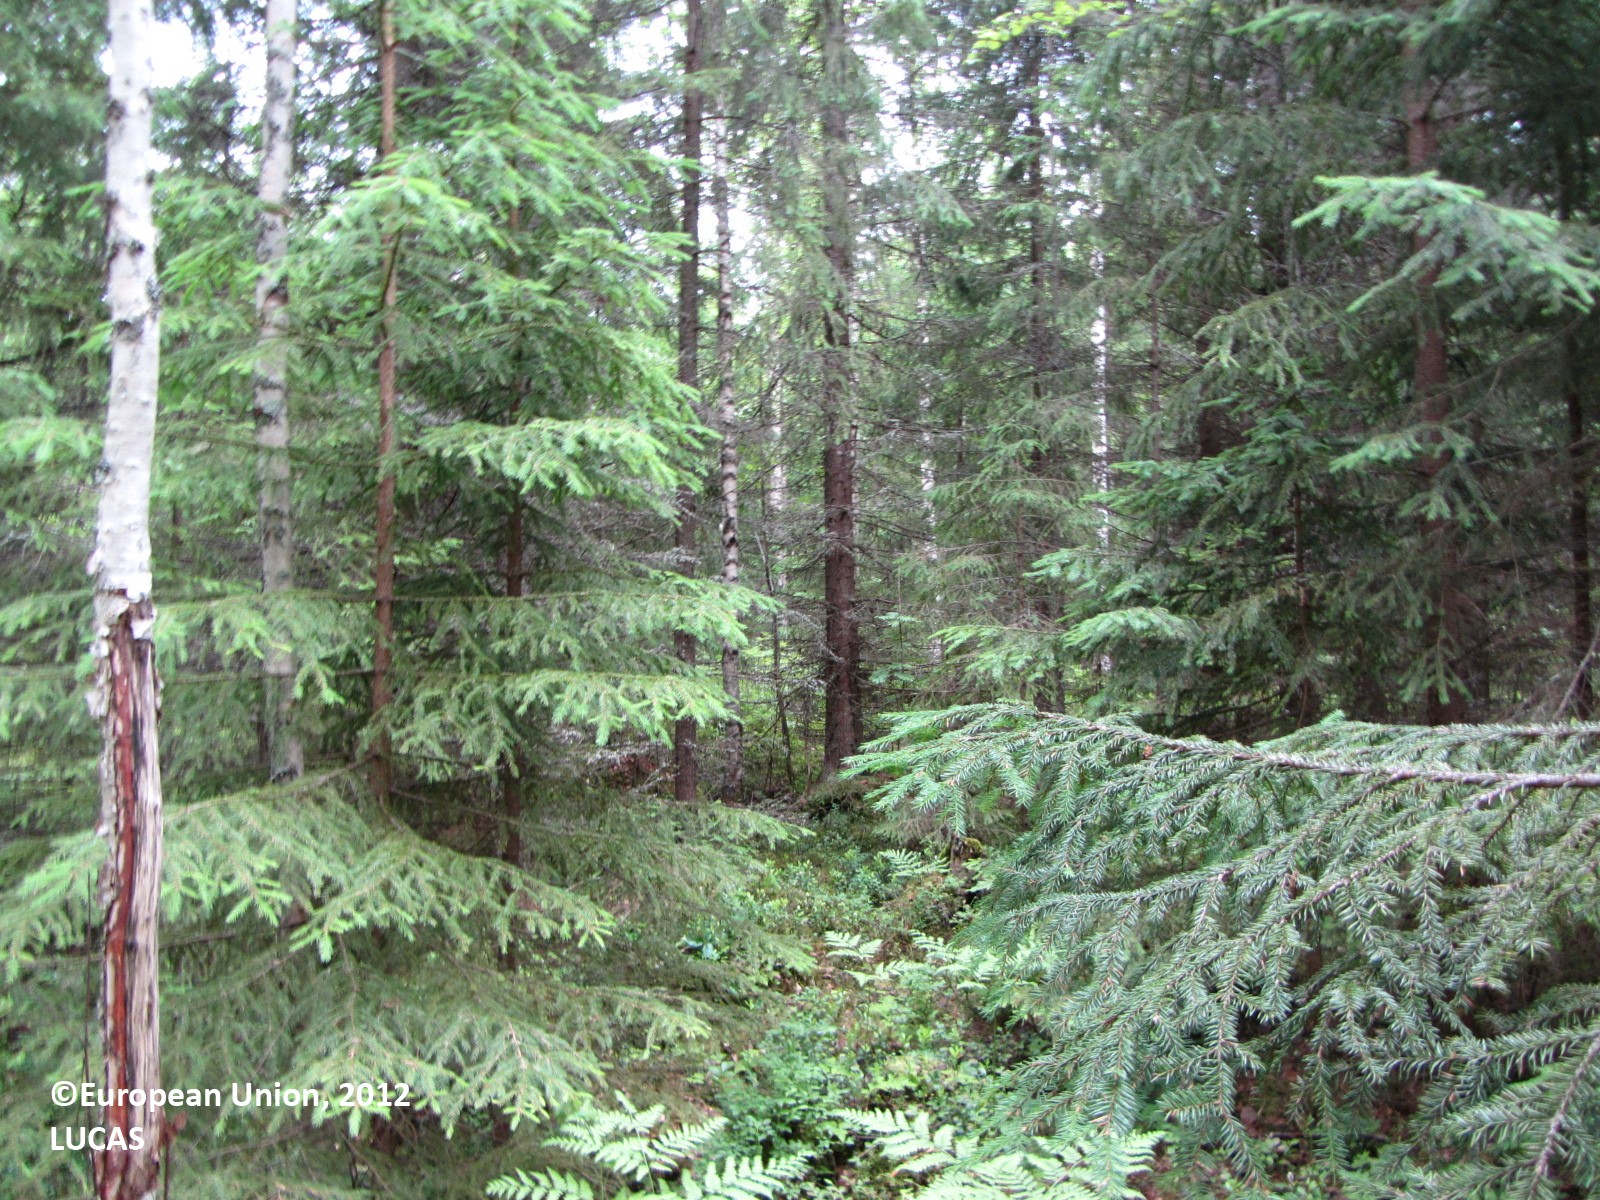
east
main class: Woodland
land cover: Spruce dominated mixed woodland
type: boreal forest
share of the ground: > 75 %
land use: Forestry
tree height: > 5 m
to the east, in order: Spruce dominated mixed woodland; Tracks; Spruce dominated mixed woodland; Spruce dominated coniferous woodland; Rock outcrops; Tracks; Pine dominated mixed woodland; Inland water bodies
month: June
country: FI
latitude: 62.6465
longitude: 25.5424
